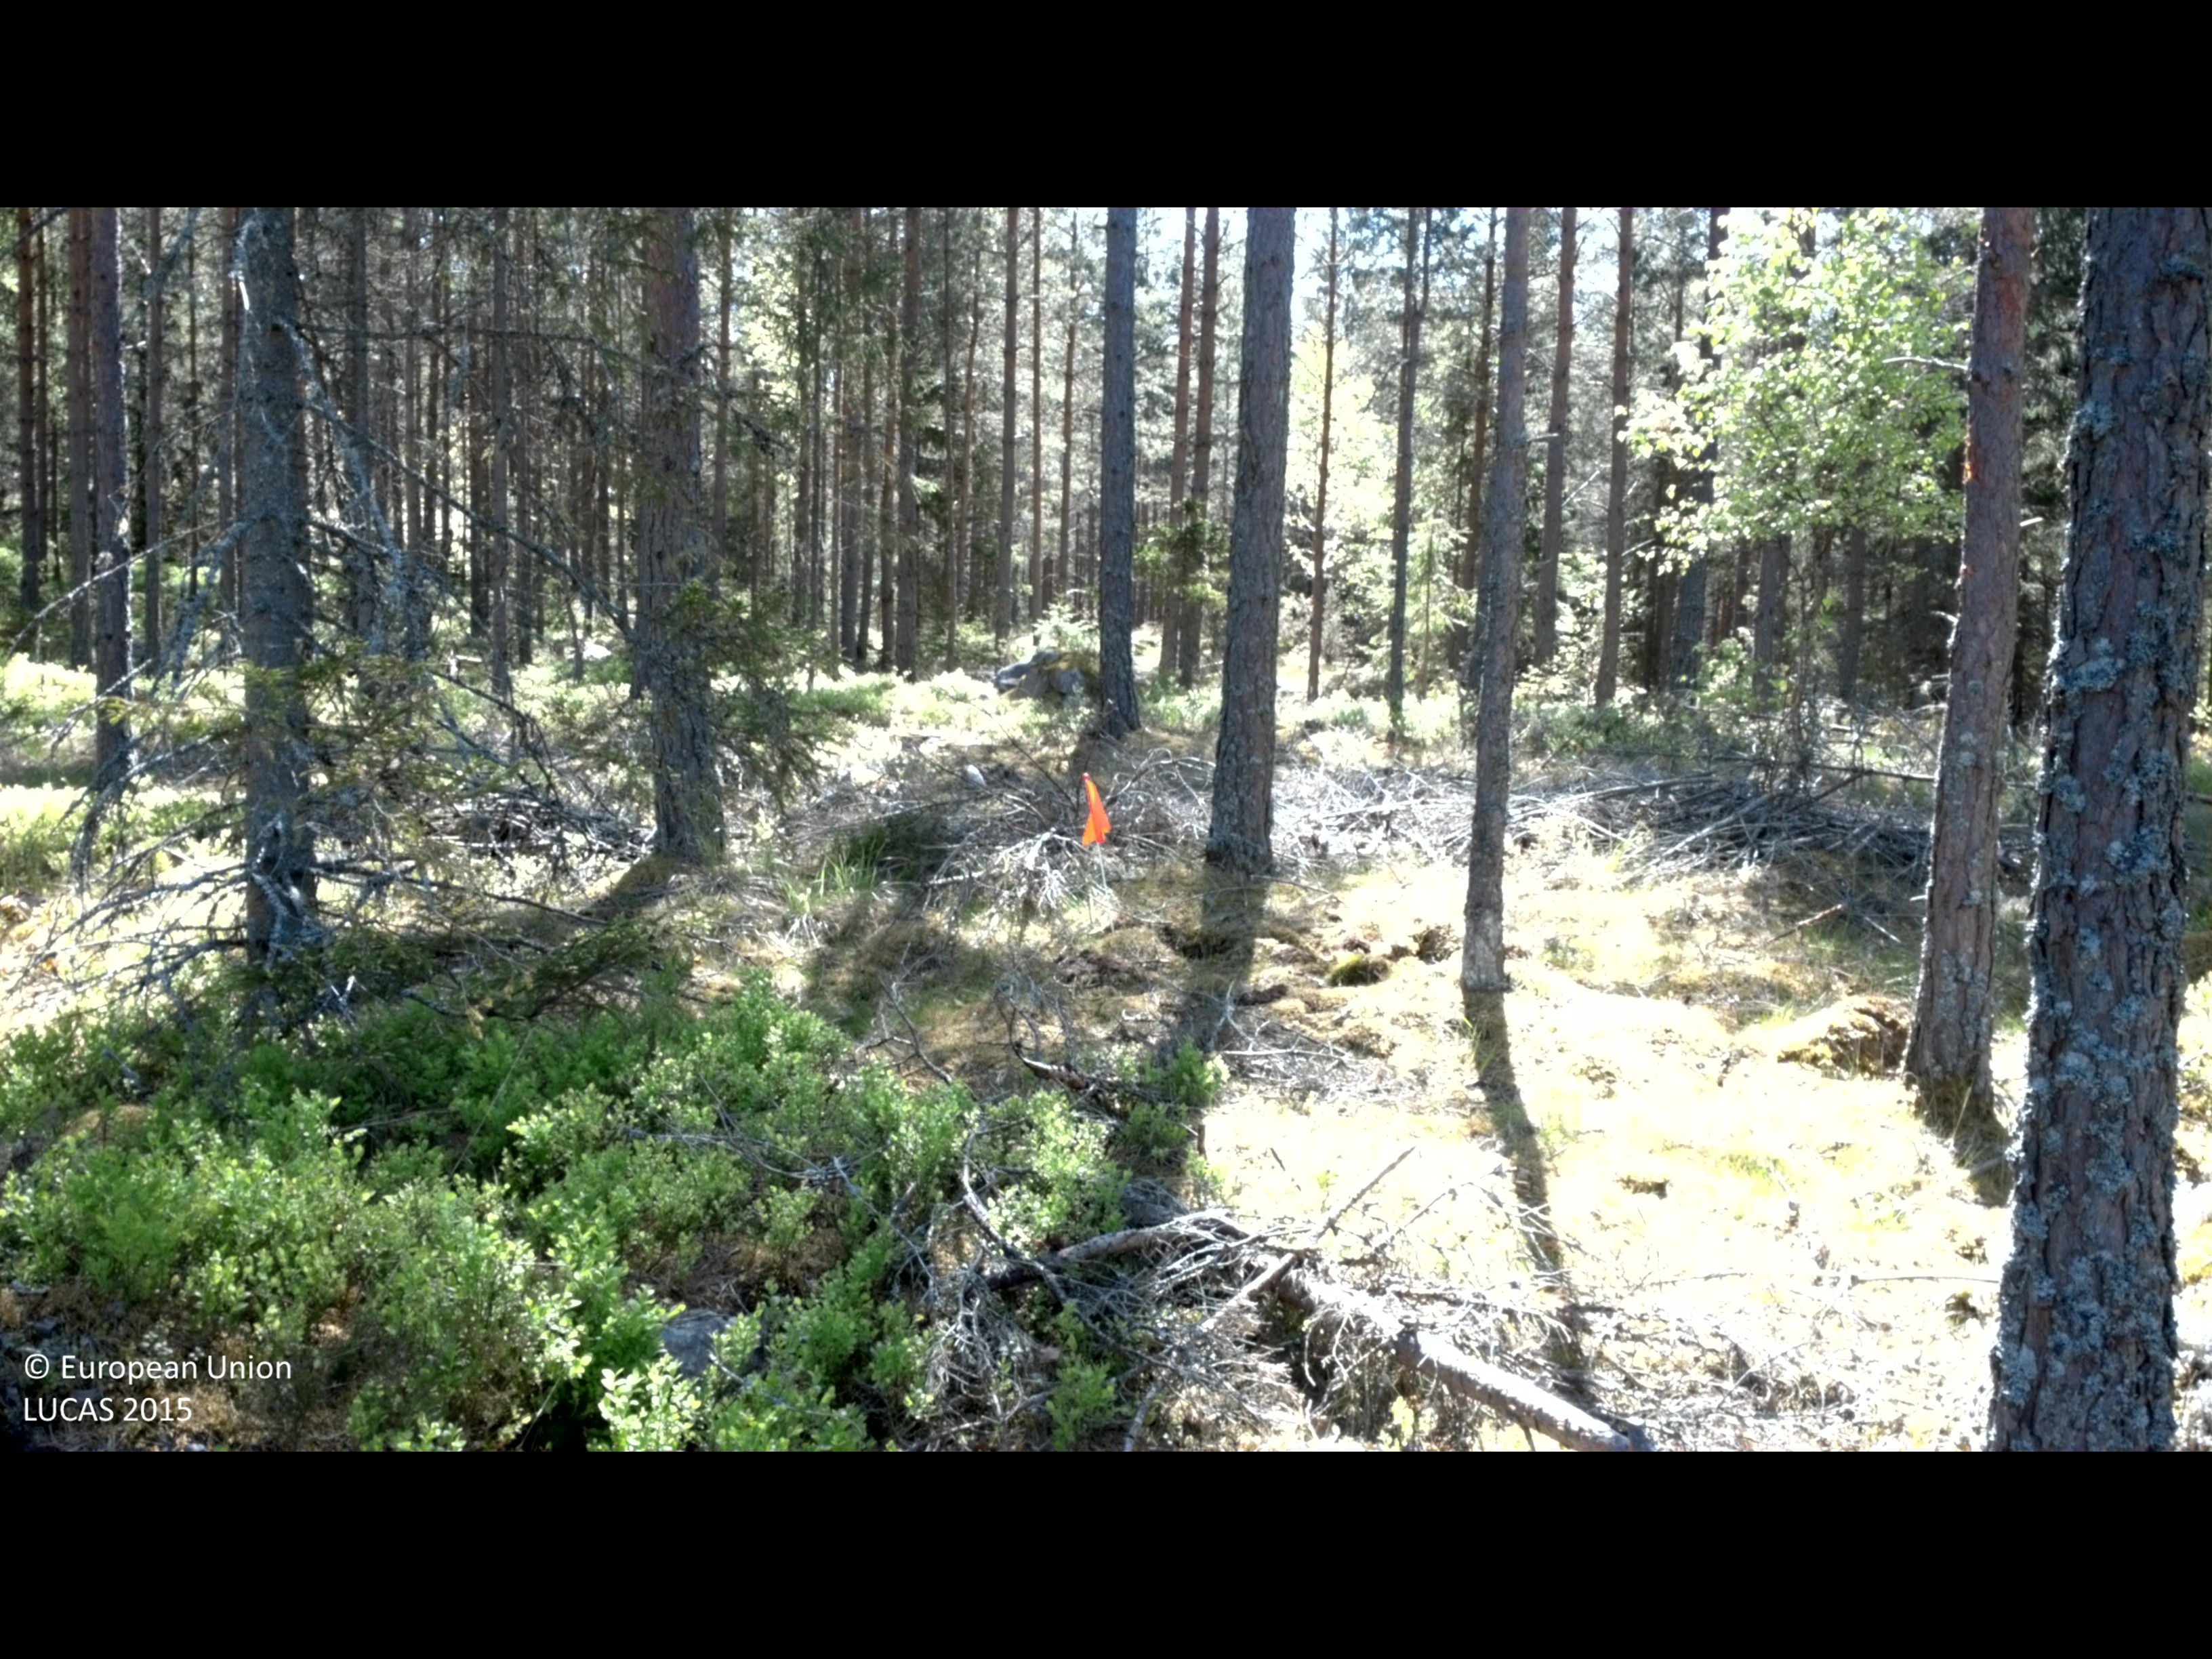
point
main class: Woodland
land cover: Pine dominated coniferous woodland
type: boreal forest
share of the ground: 50 - 75 %
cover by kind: coniferous forest trees 70 %, shrubs 20 %, herbaceous plants 10 %
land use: Forestry
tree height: > 5 m
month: May
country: SE
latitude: 57.2684
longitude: 16.1176
